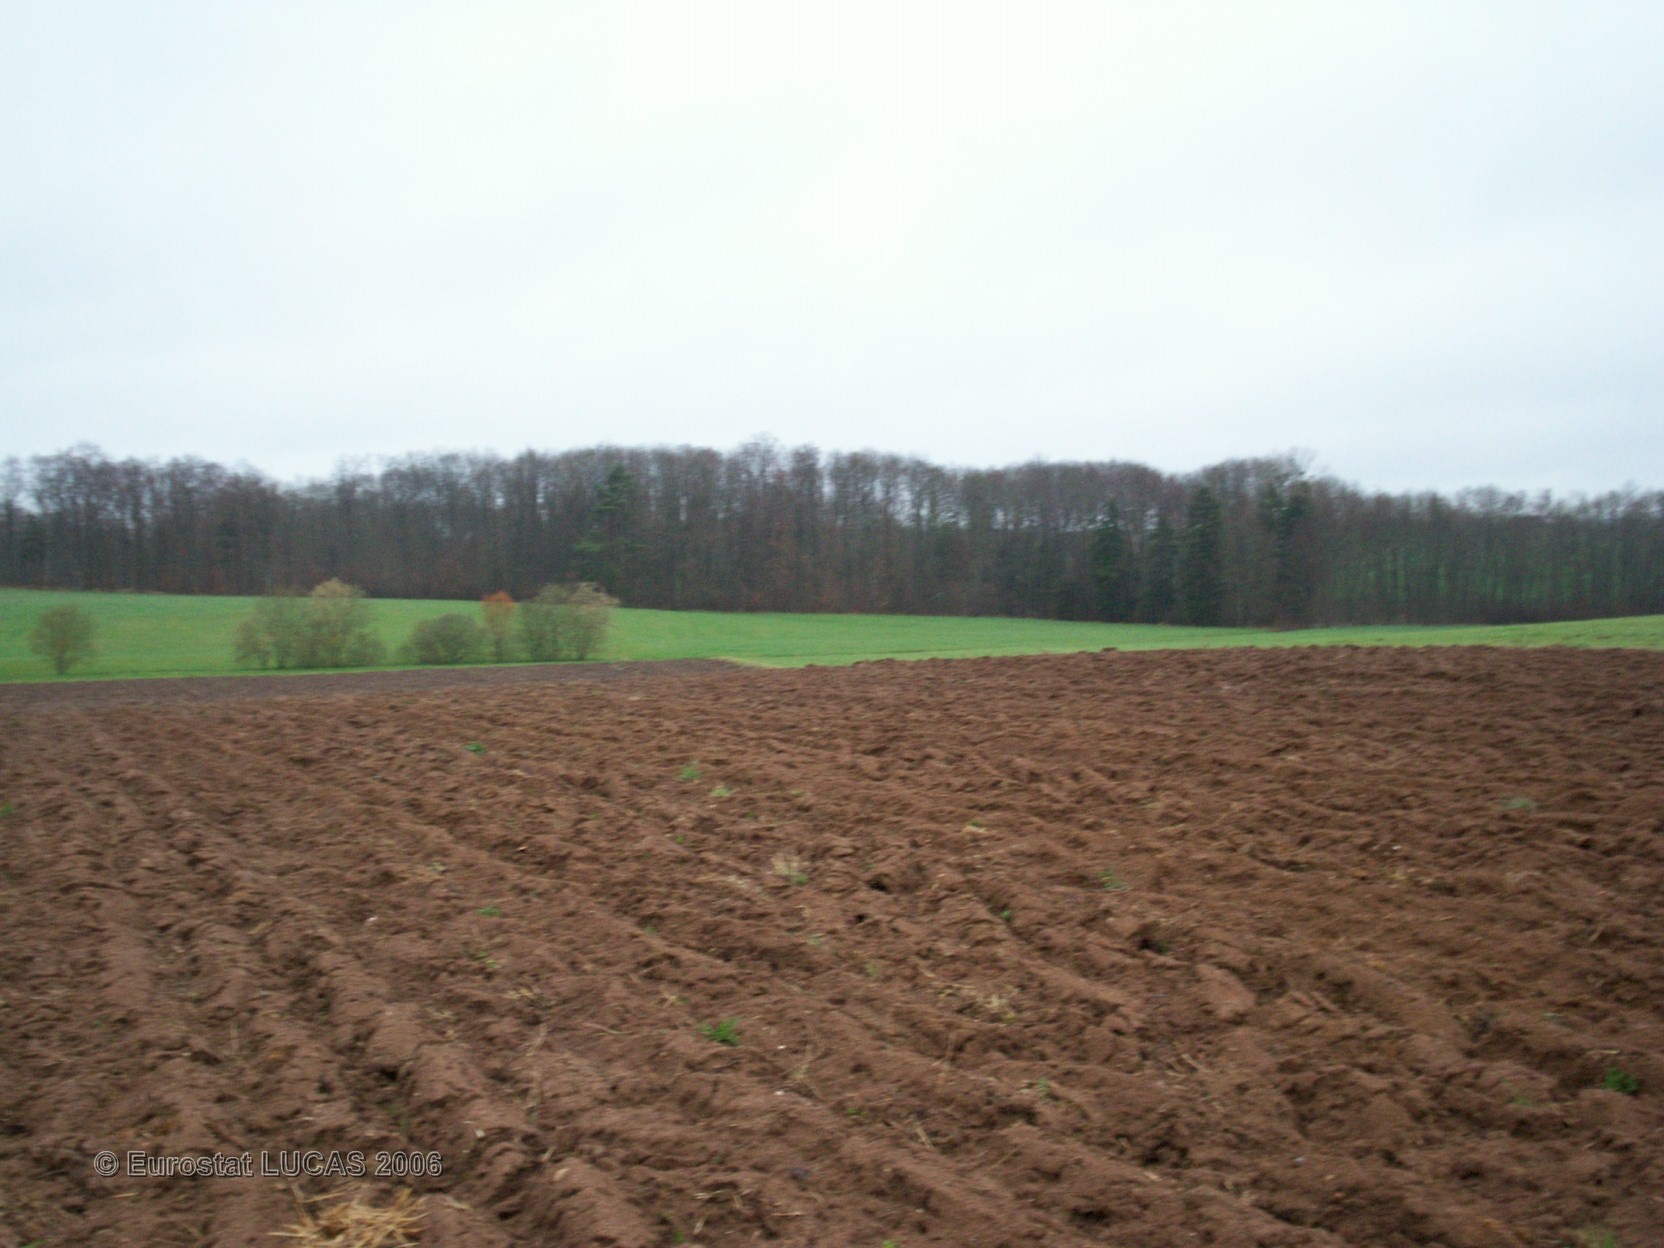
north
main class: Cropland
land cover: Maize
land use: Agriculture (excluding fallow land and kitchen gardens)
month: May
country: FR
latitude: 48.5902
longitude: 6.7602
